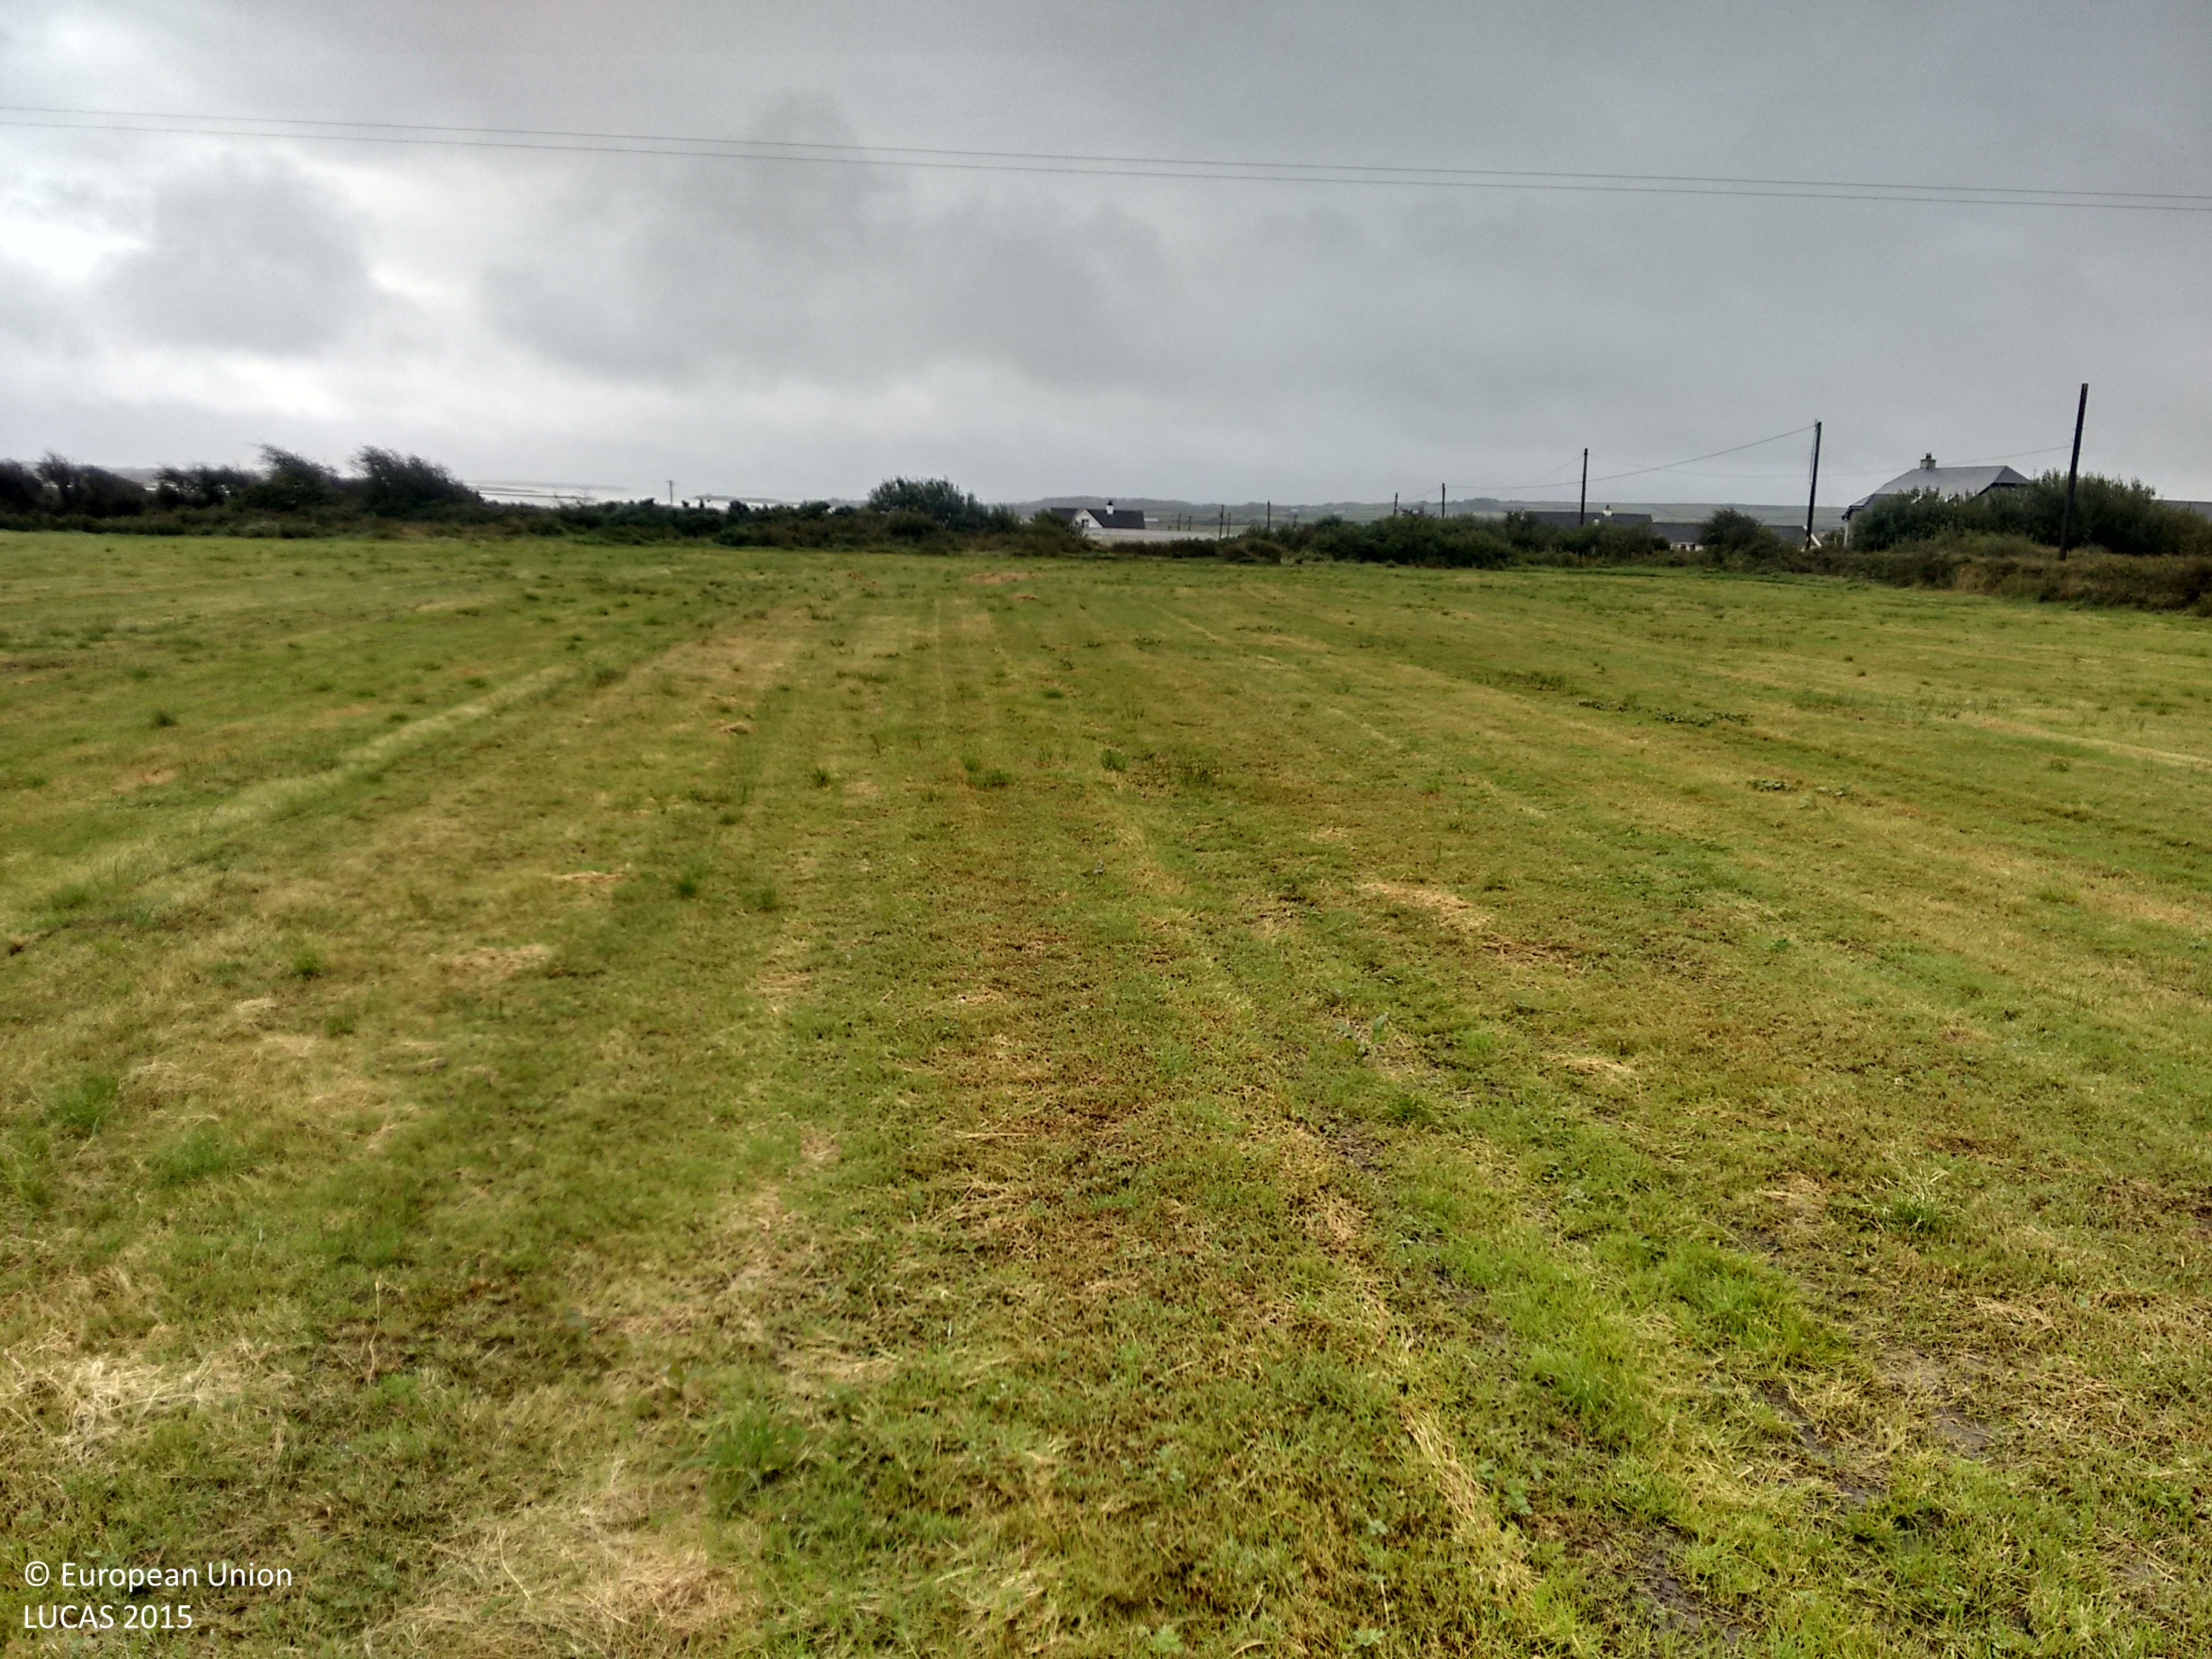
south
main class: Grassland
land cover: Grassland without tree/shrub cover
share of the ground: > 75 %
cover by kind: herbaceous plants 95 %, unconsolidated bare surface 5 %
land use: Agriculture (excluding fallow land and kitchen gardens)
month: September
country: IE
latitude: 52.6717
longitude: -9.5644
